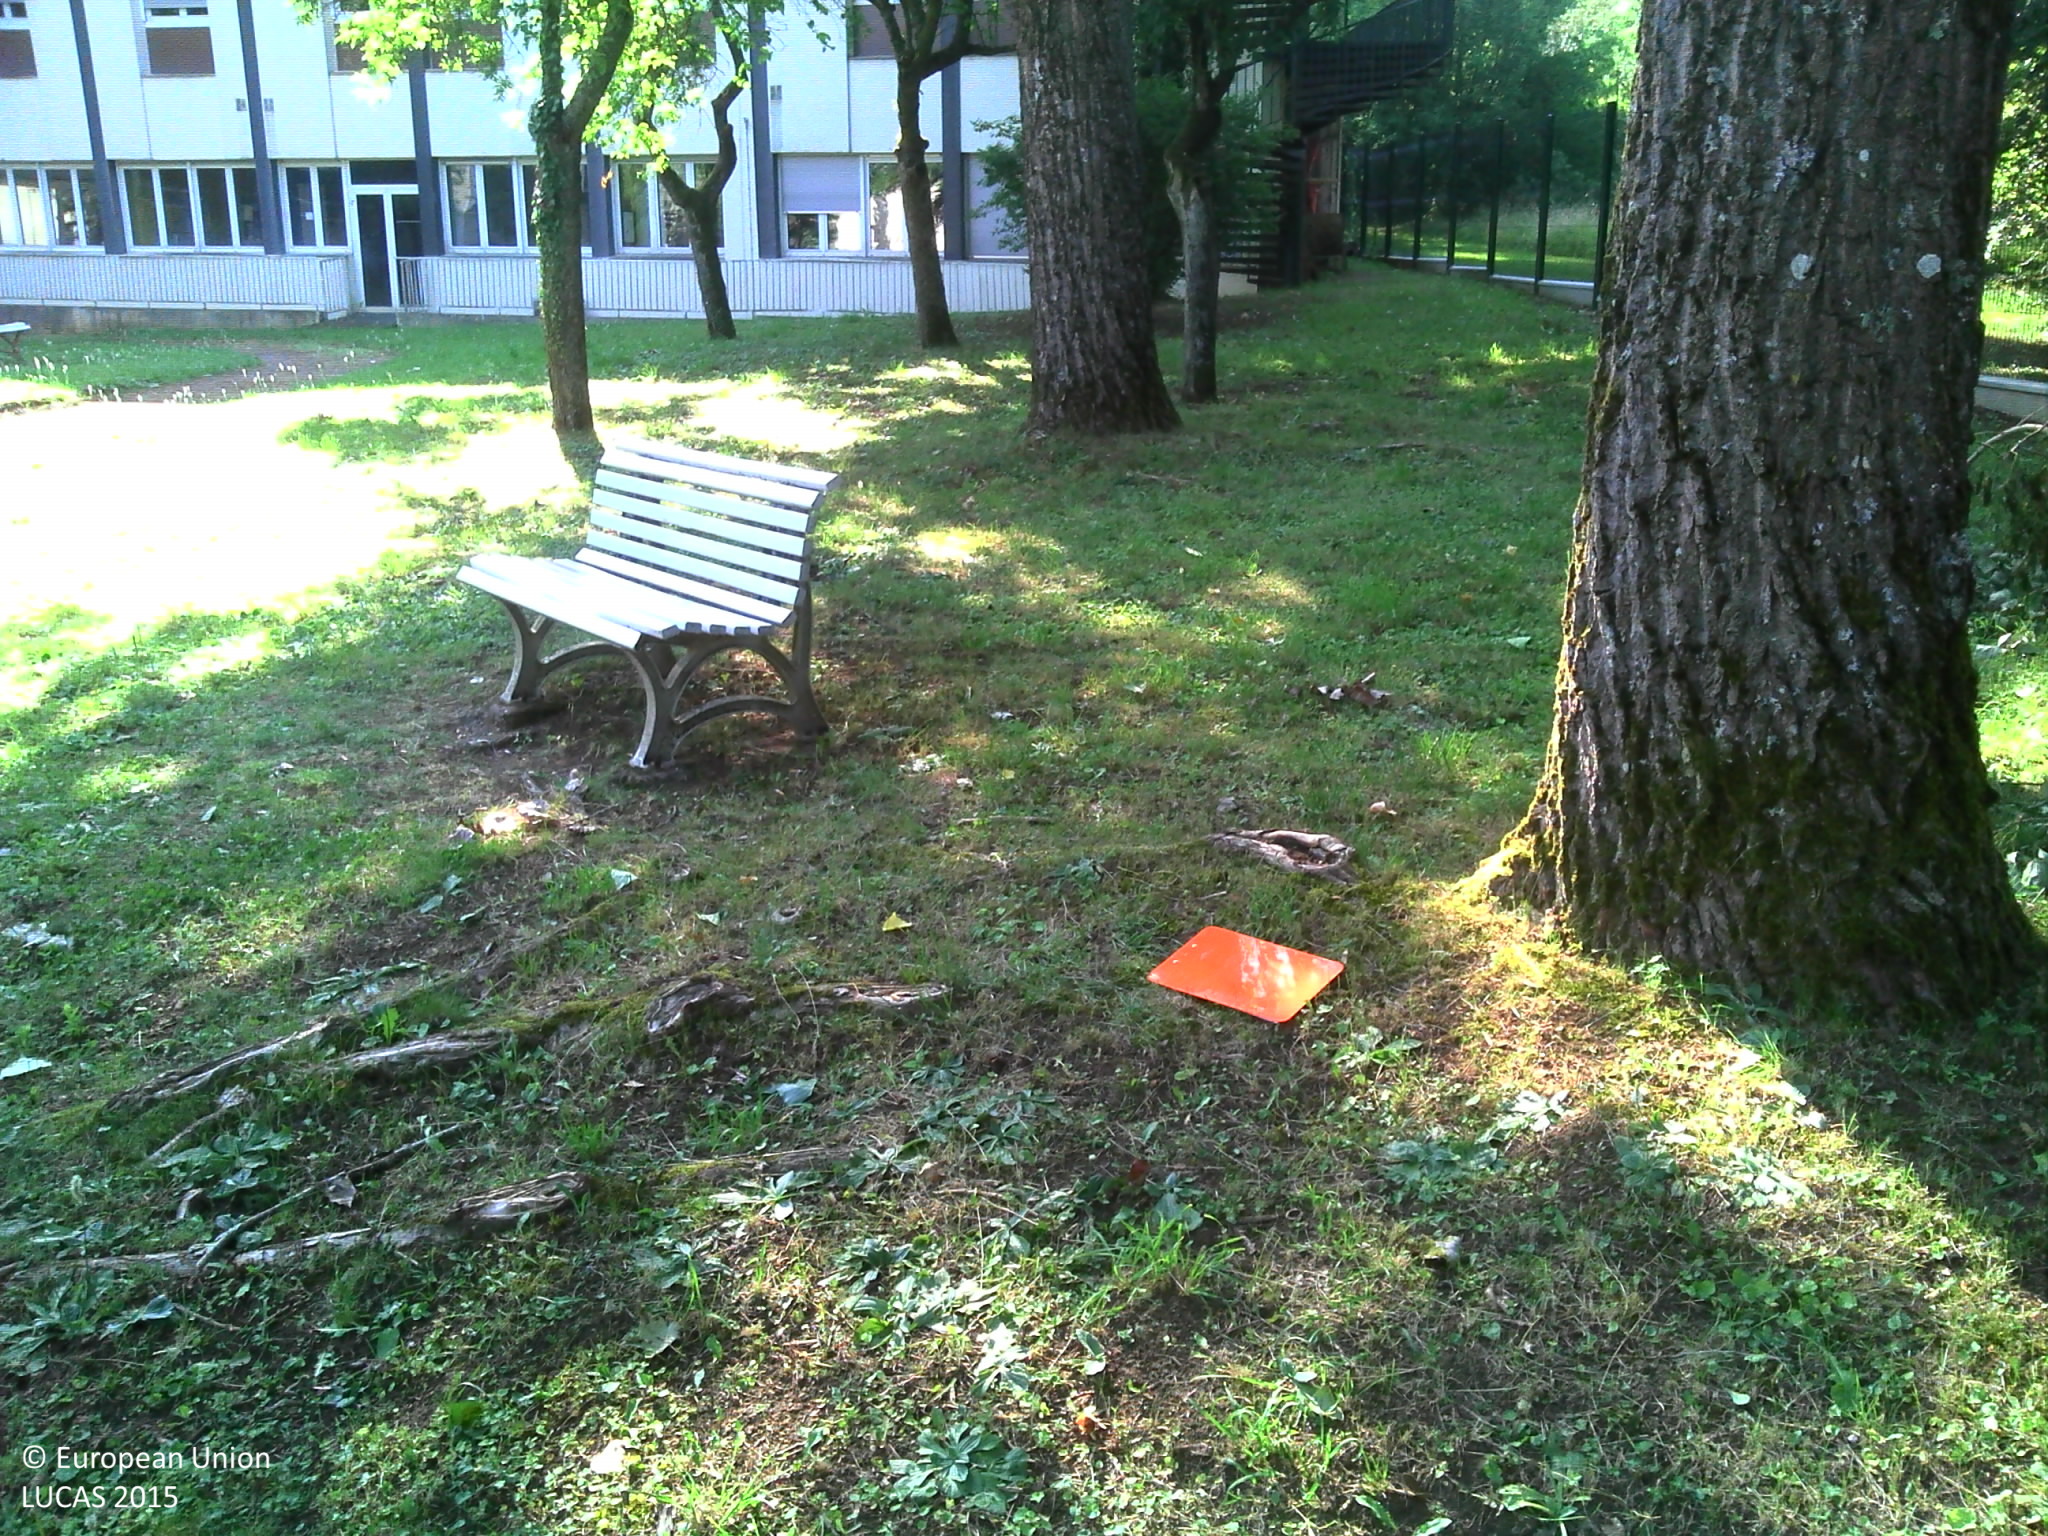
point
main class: Woodland
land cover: Broadleaved woodland
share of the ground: > 75 %
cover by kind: broadleaved forest trees 80 %, herbaceous plants 20 %
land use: Community services
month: July
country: FR
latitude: 48.6610
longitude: 6.1578
